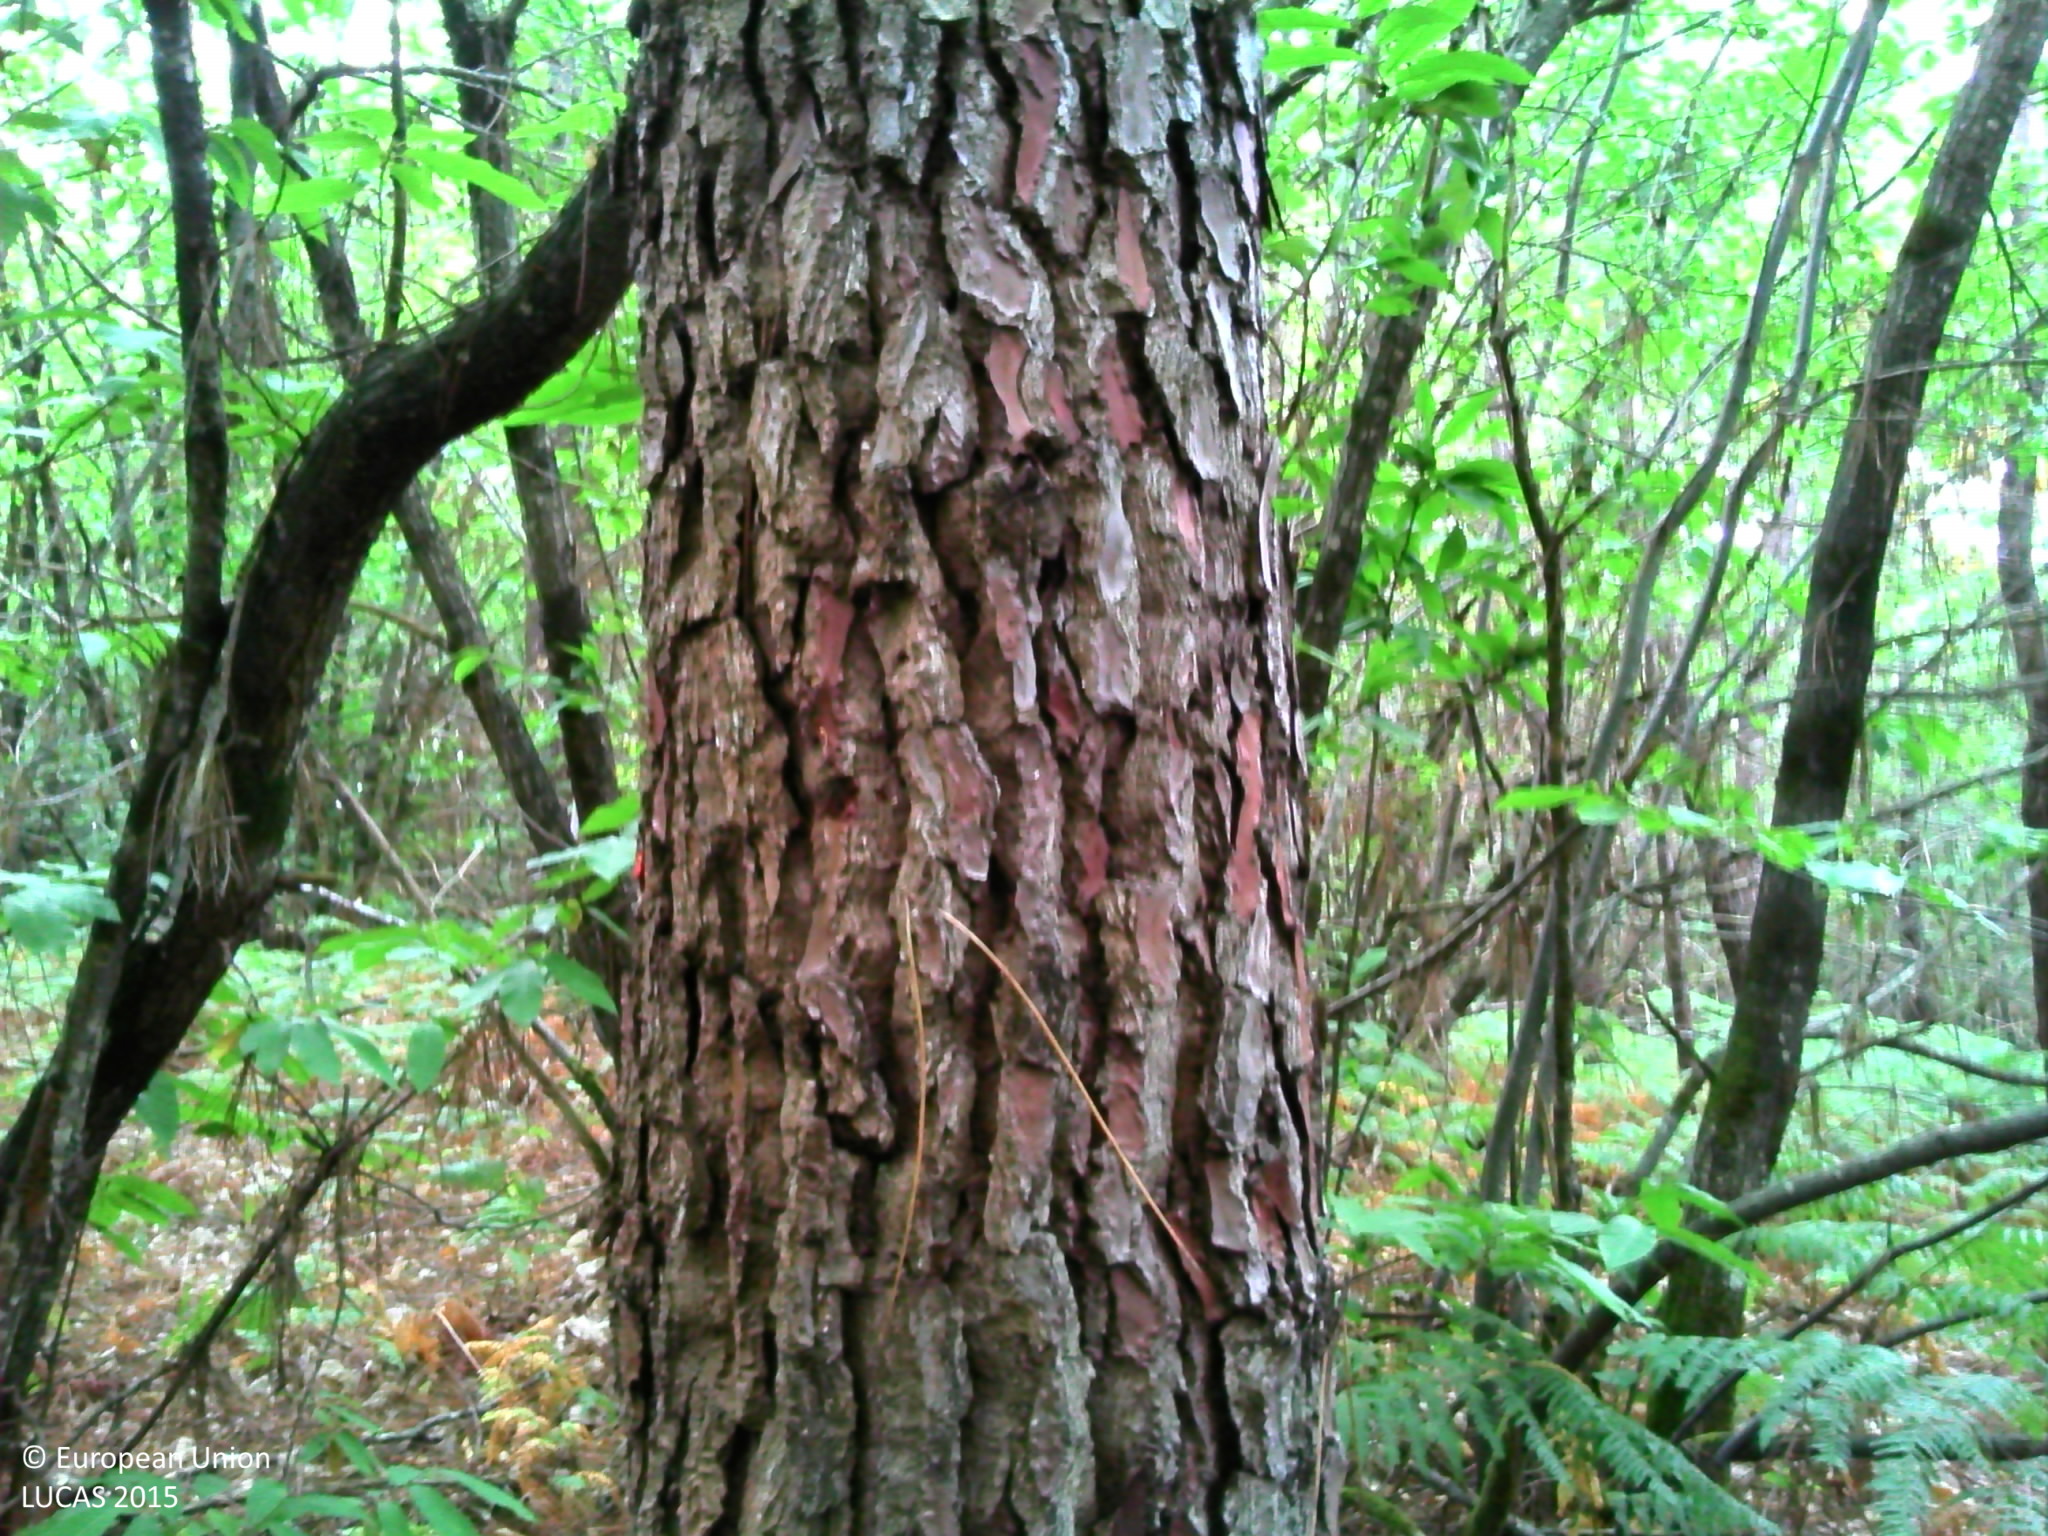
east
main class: Woodland
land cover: Pine dominated mixed woodland
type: thermophilous deciduous forest
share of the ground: > 75 %
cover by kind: broadleaved forest trees 55 %, coniferous forest trees 20 %, herbaceous plants 10 %, lichens and mosses 10 %, shrubs 5 %
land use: Forestry
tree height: > 5 m
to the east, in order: Pine dominated mixed woodland; Broadleaved woodland; Grassland without tree/shrub cover
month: July
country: FR
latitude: 44.9859
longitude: 0.9243
